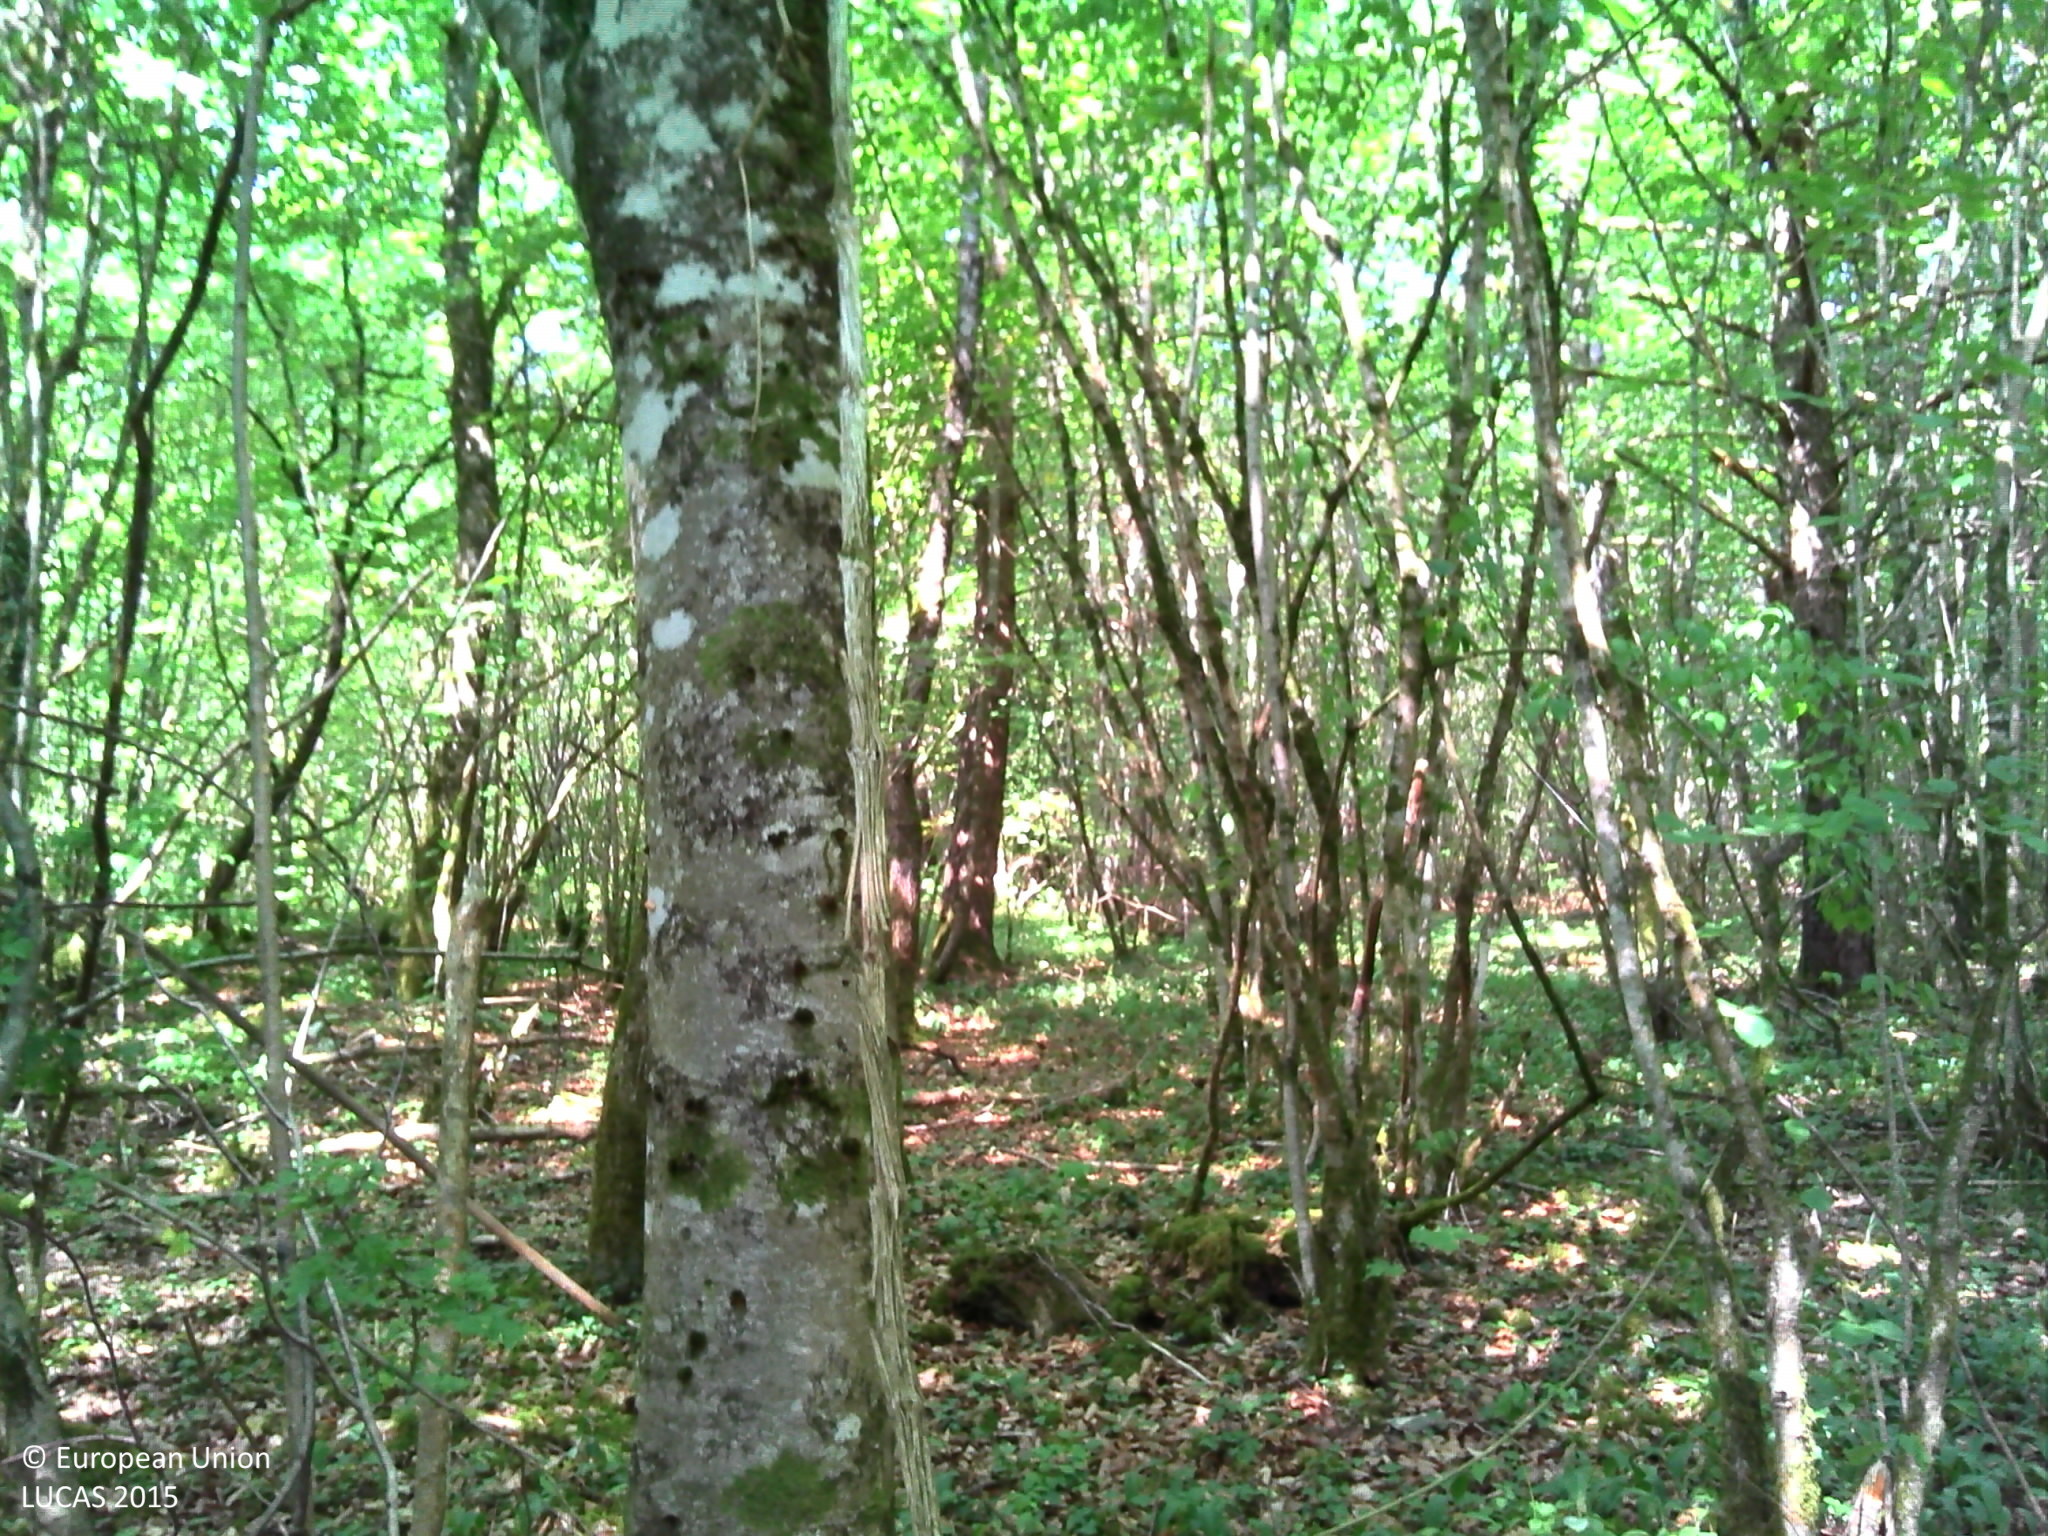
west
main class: Woodland
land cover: Broadleaved woodland
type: mesophytic deciduous forest
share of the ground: > 75 %
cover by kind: broadleaved forest trees 75 %, coniferous forest trees 10 %, lichens and mosses 10 %, herbaceous plants 5 %
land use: Forestry
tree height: > 5 m
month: July
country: FR
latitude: 48.1573
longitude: 4.8498
